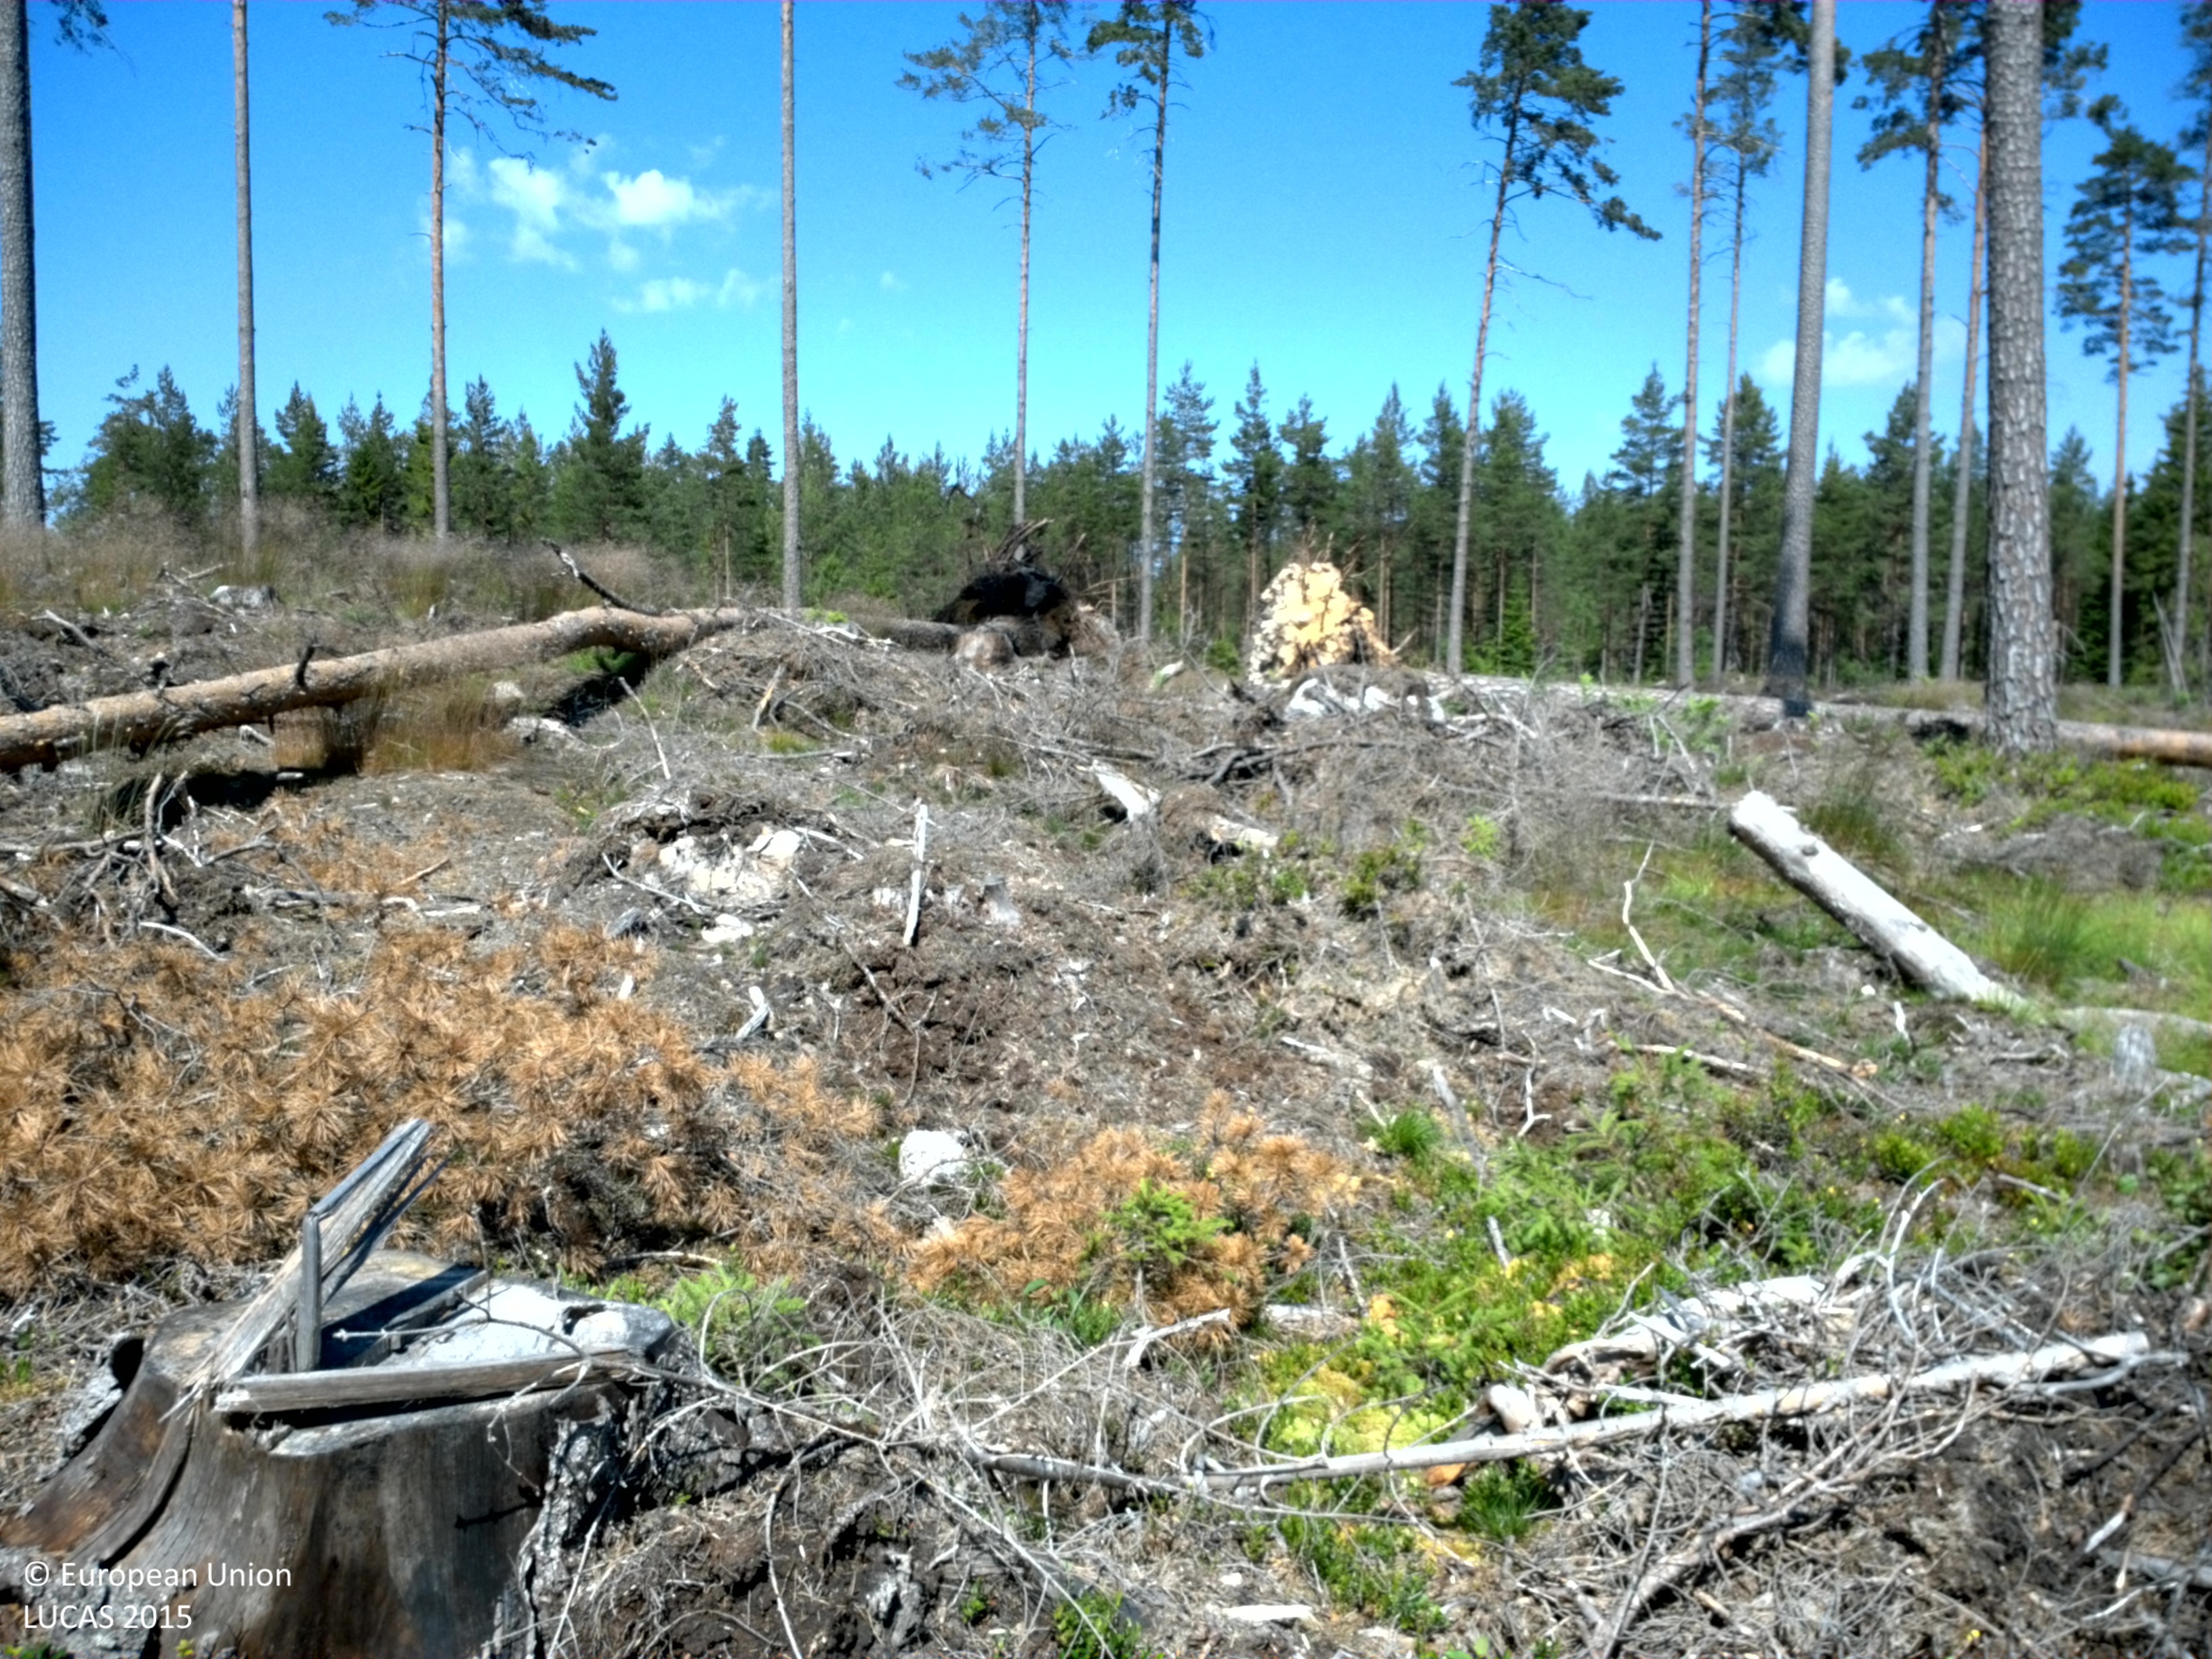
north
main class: Woodland
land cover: Pine dominated coniferous woodland
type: boreal forest
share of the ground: 10 - 25 %
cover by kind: herbaceous plants 60 %, lichens and mosses 30 %, coniferous forest trees 10 %
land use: Forestry
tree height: > 5 m
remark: Clear cut
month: July
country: SE
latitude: 58.7712
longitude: 14.6100
